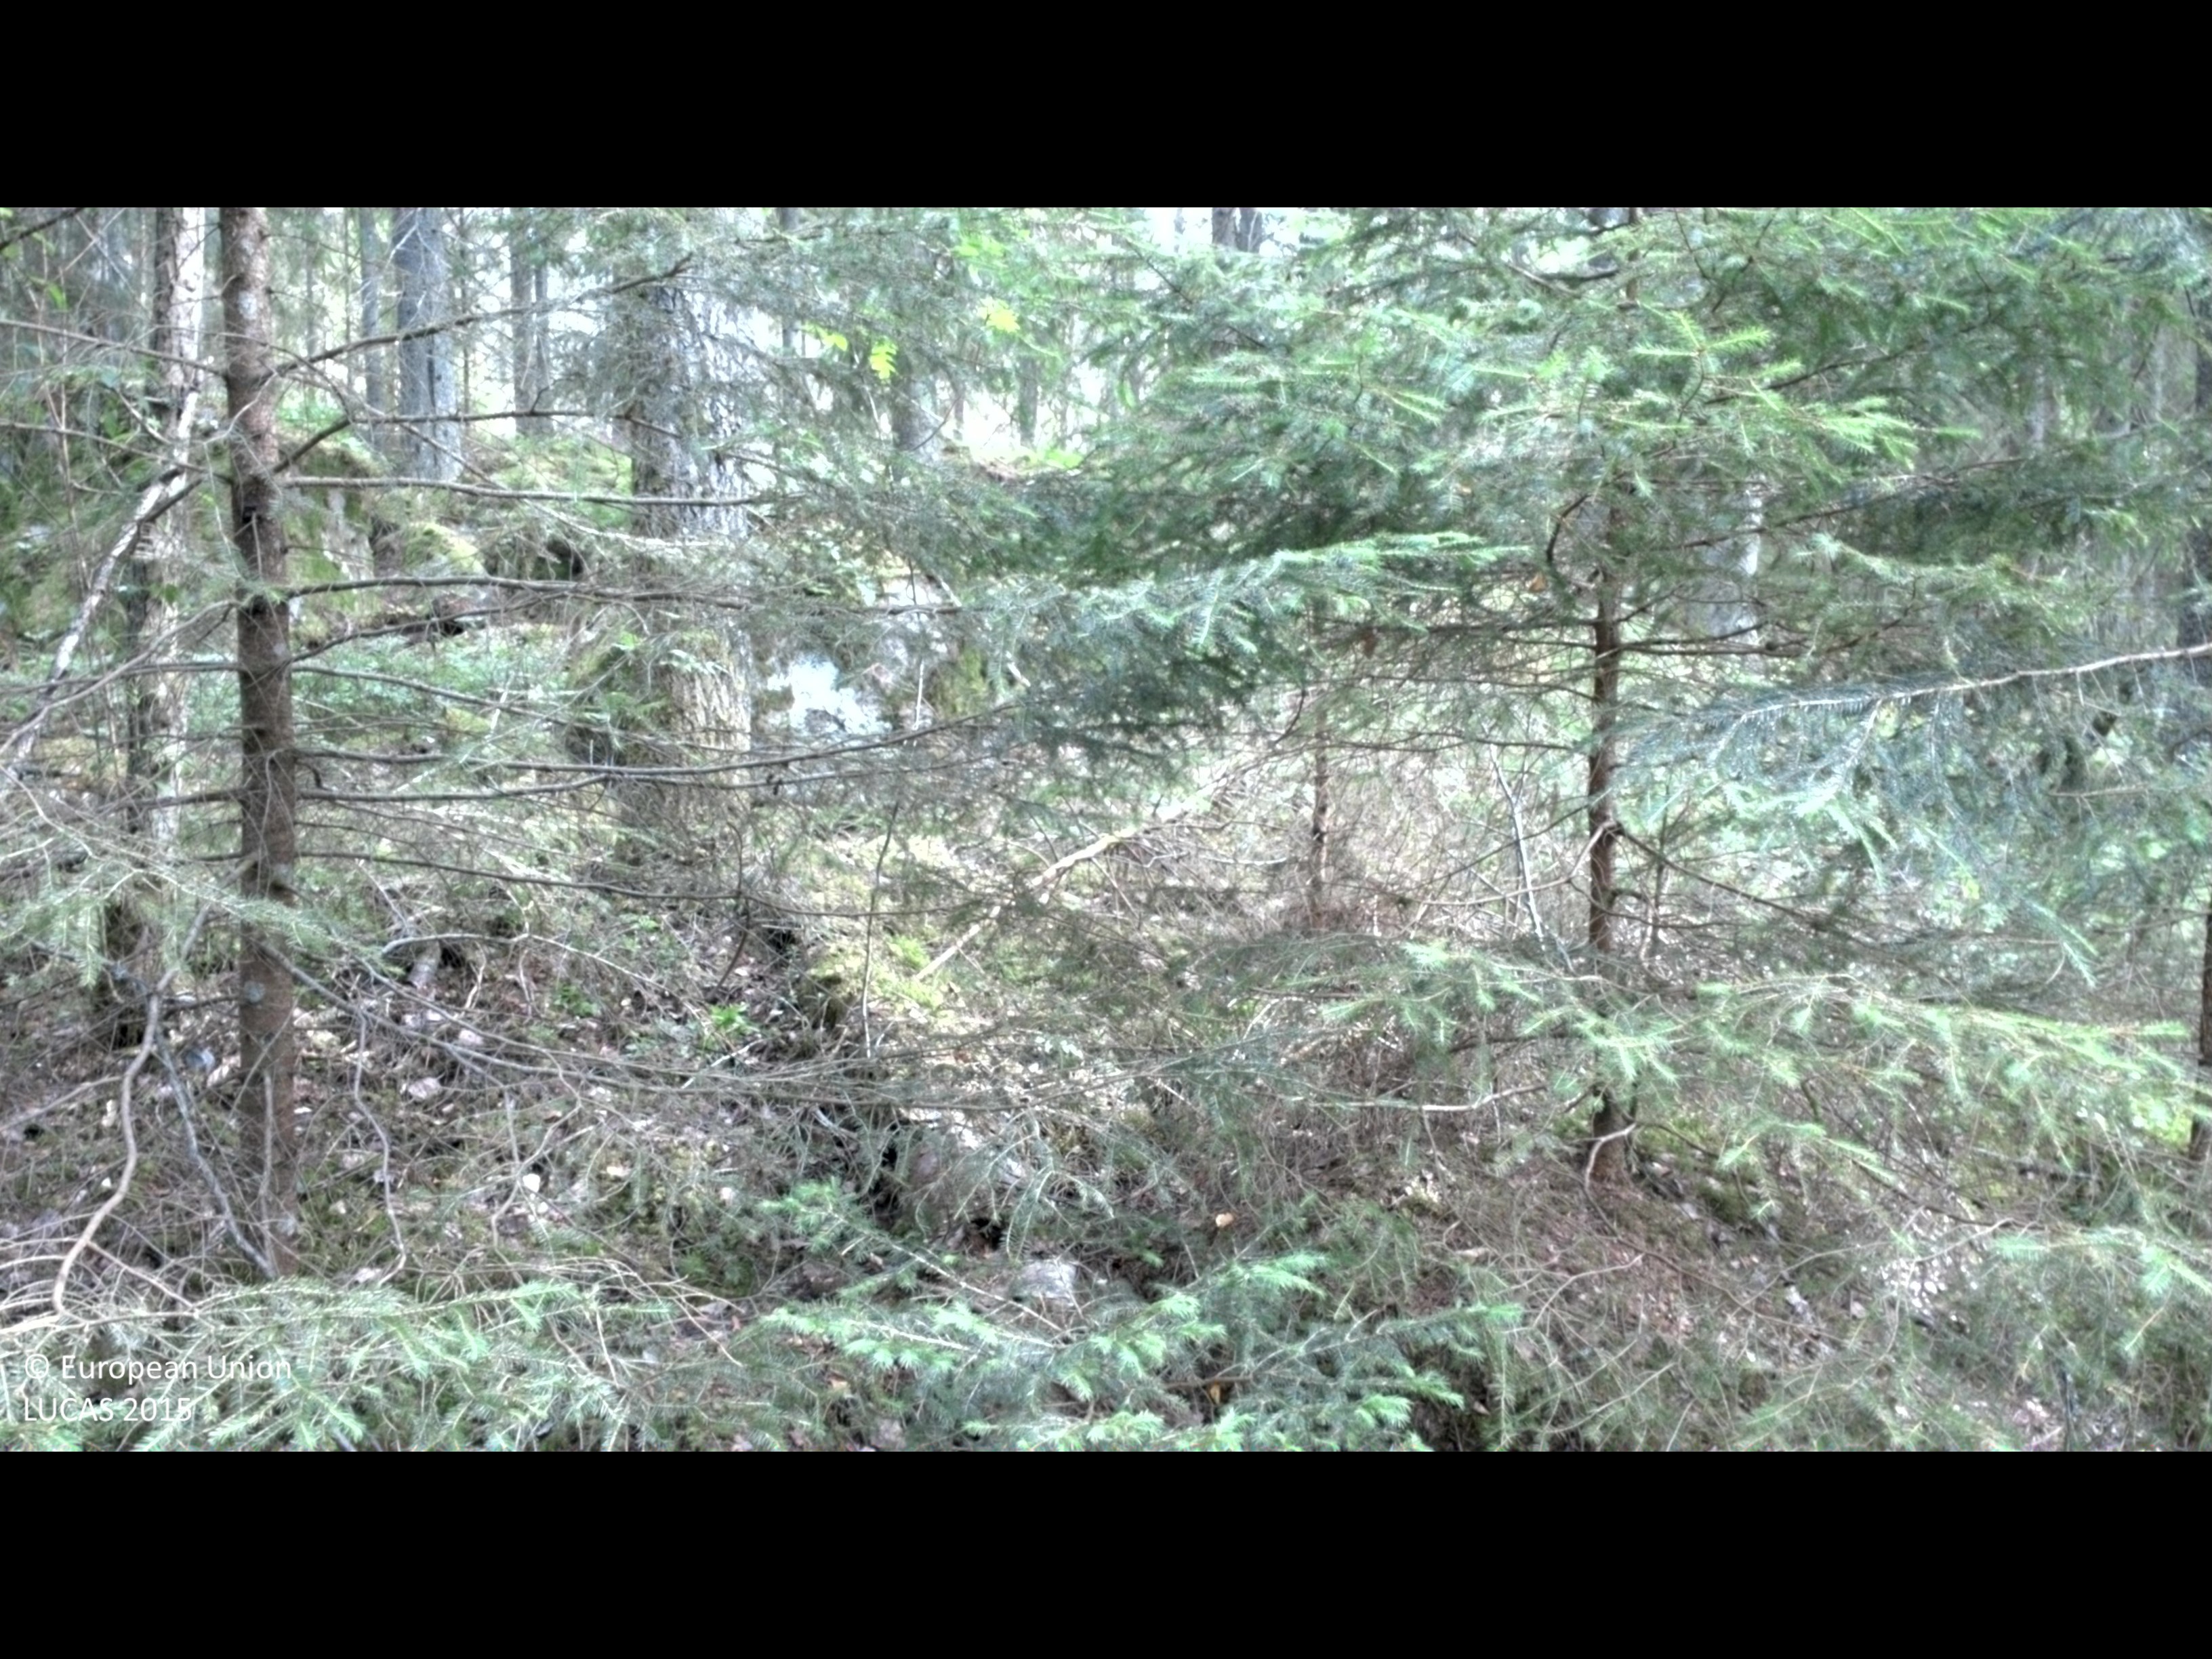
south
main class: Woodland
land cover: Spruce dominated coniferous woodland
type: boreal forest
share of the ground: > 75 %
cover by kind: coniferous forest trees 65 %, broadleaved forest trees 15 %, shrubs 15 %, lichens and mosses 5 %
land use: Forestry
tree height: > 5 m
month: July
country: SE
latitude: 57.9206
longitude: 16.0574
